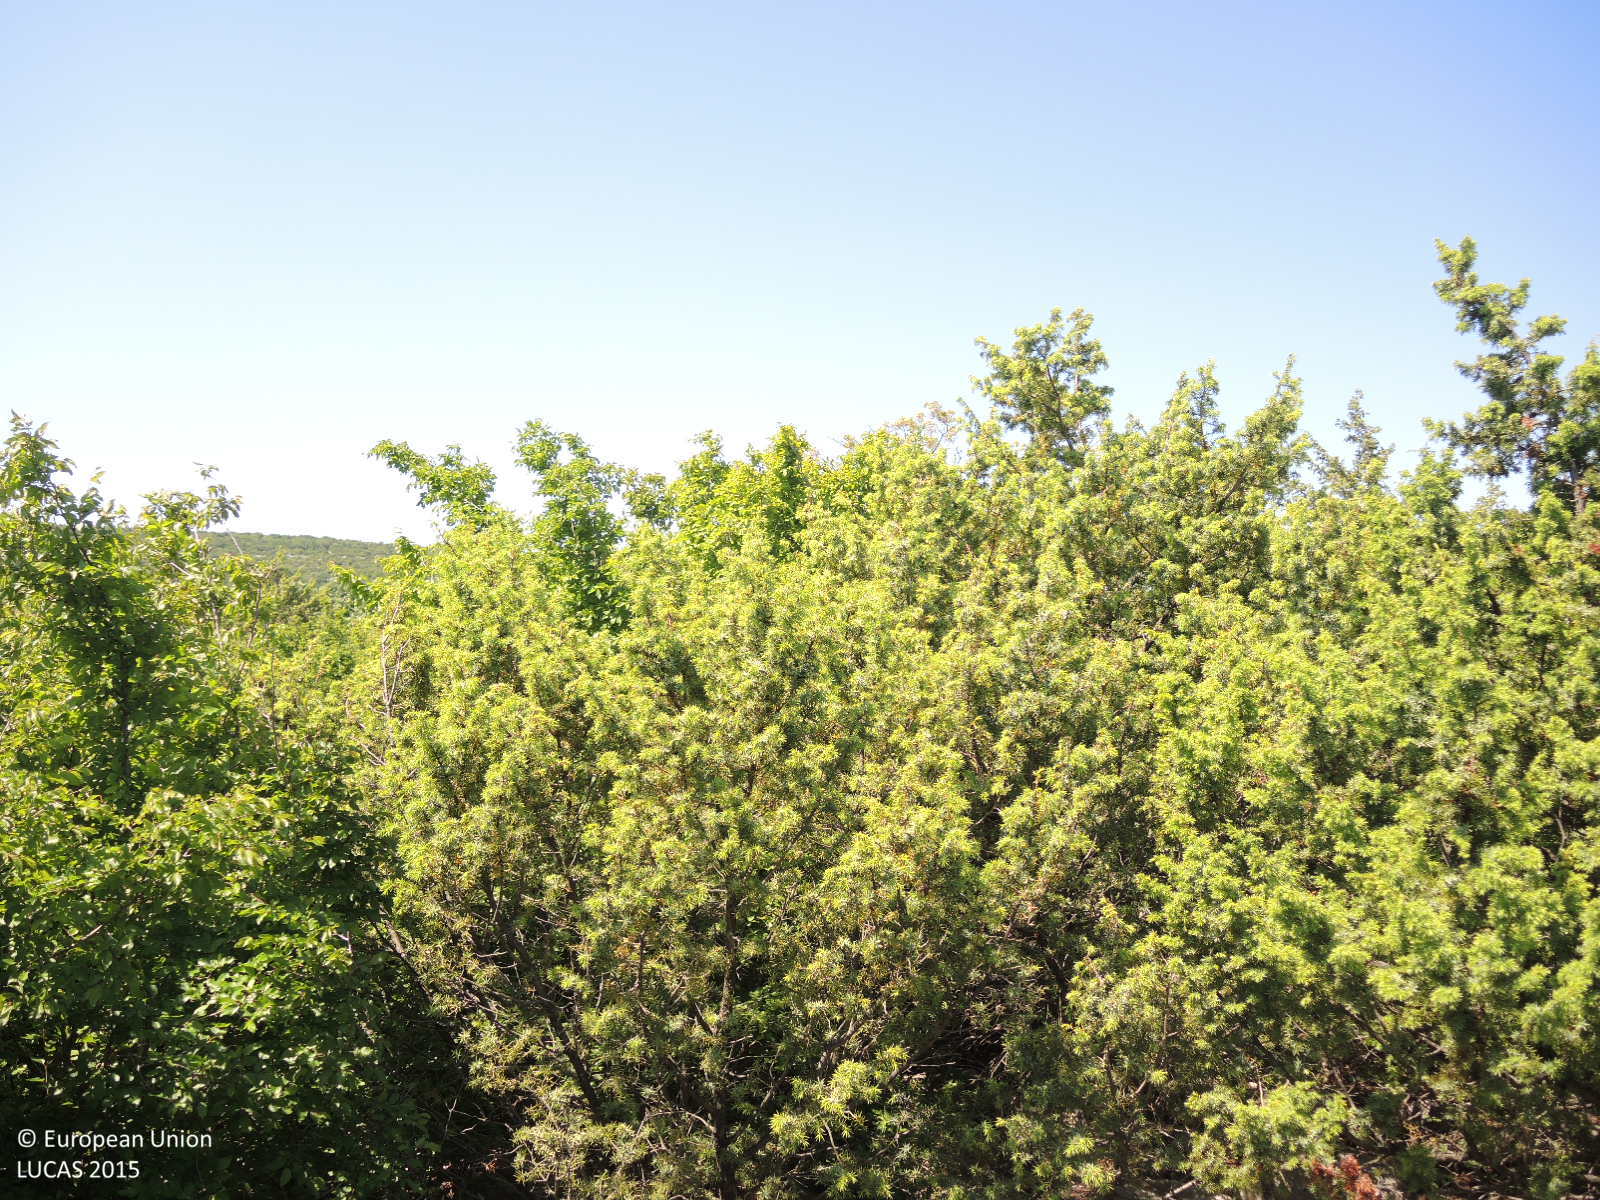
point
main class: Shrubland
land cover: Shrubland without tree cover
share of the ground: > 75 %
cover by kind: shrubs 90 %, unconsolidated bare surface 10 %
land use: Semi-natural and natural areas not in use
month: May
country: HR
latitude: 44.0301
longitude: 15.7190
